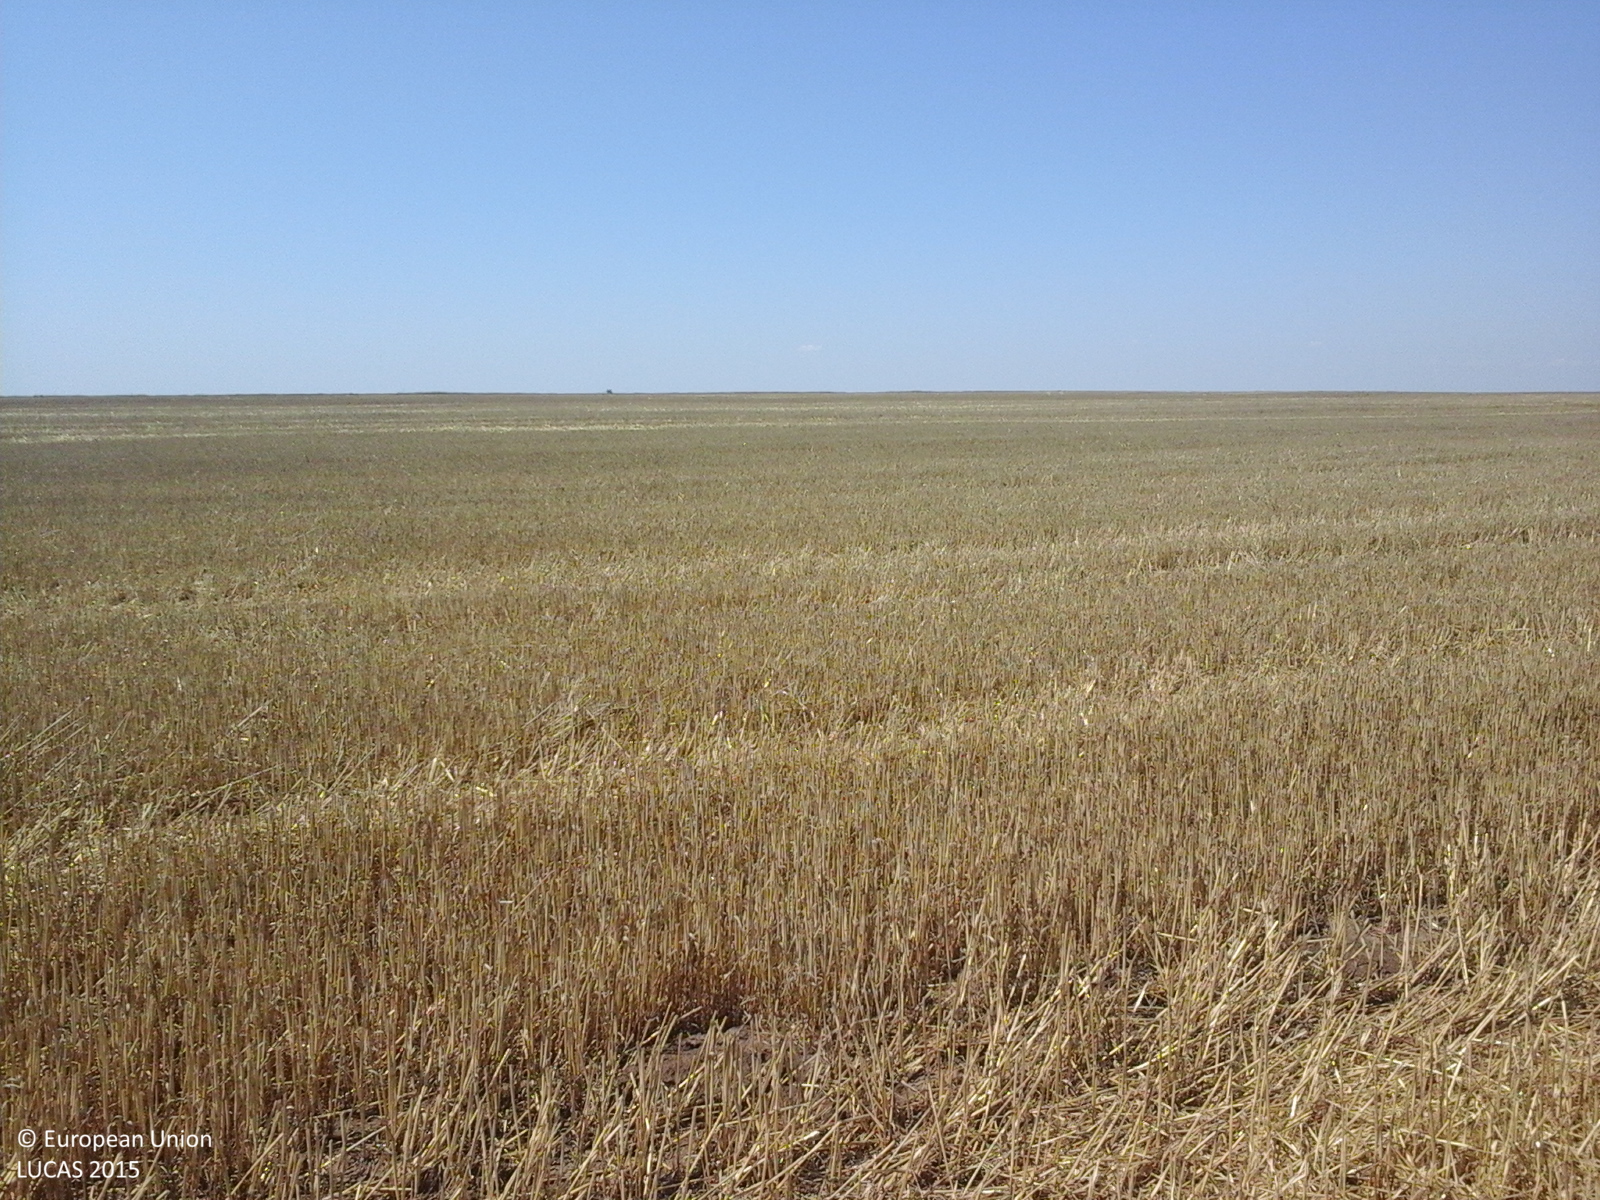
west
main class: Cropland
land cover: Common wheat
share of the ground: > 75 %
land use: Agriculture (excluding fallow land and kitchen gardens)
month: August
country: RO
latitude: 44.1971
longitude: 28.5265
